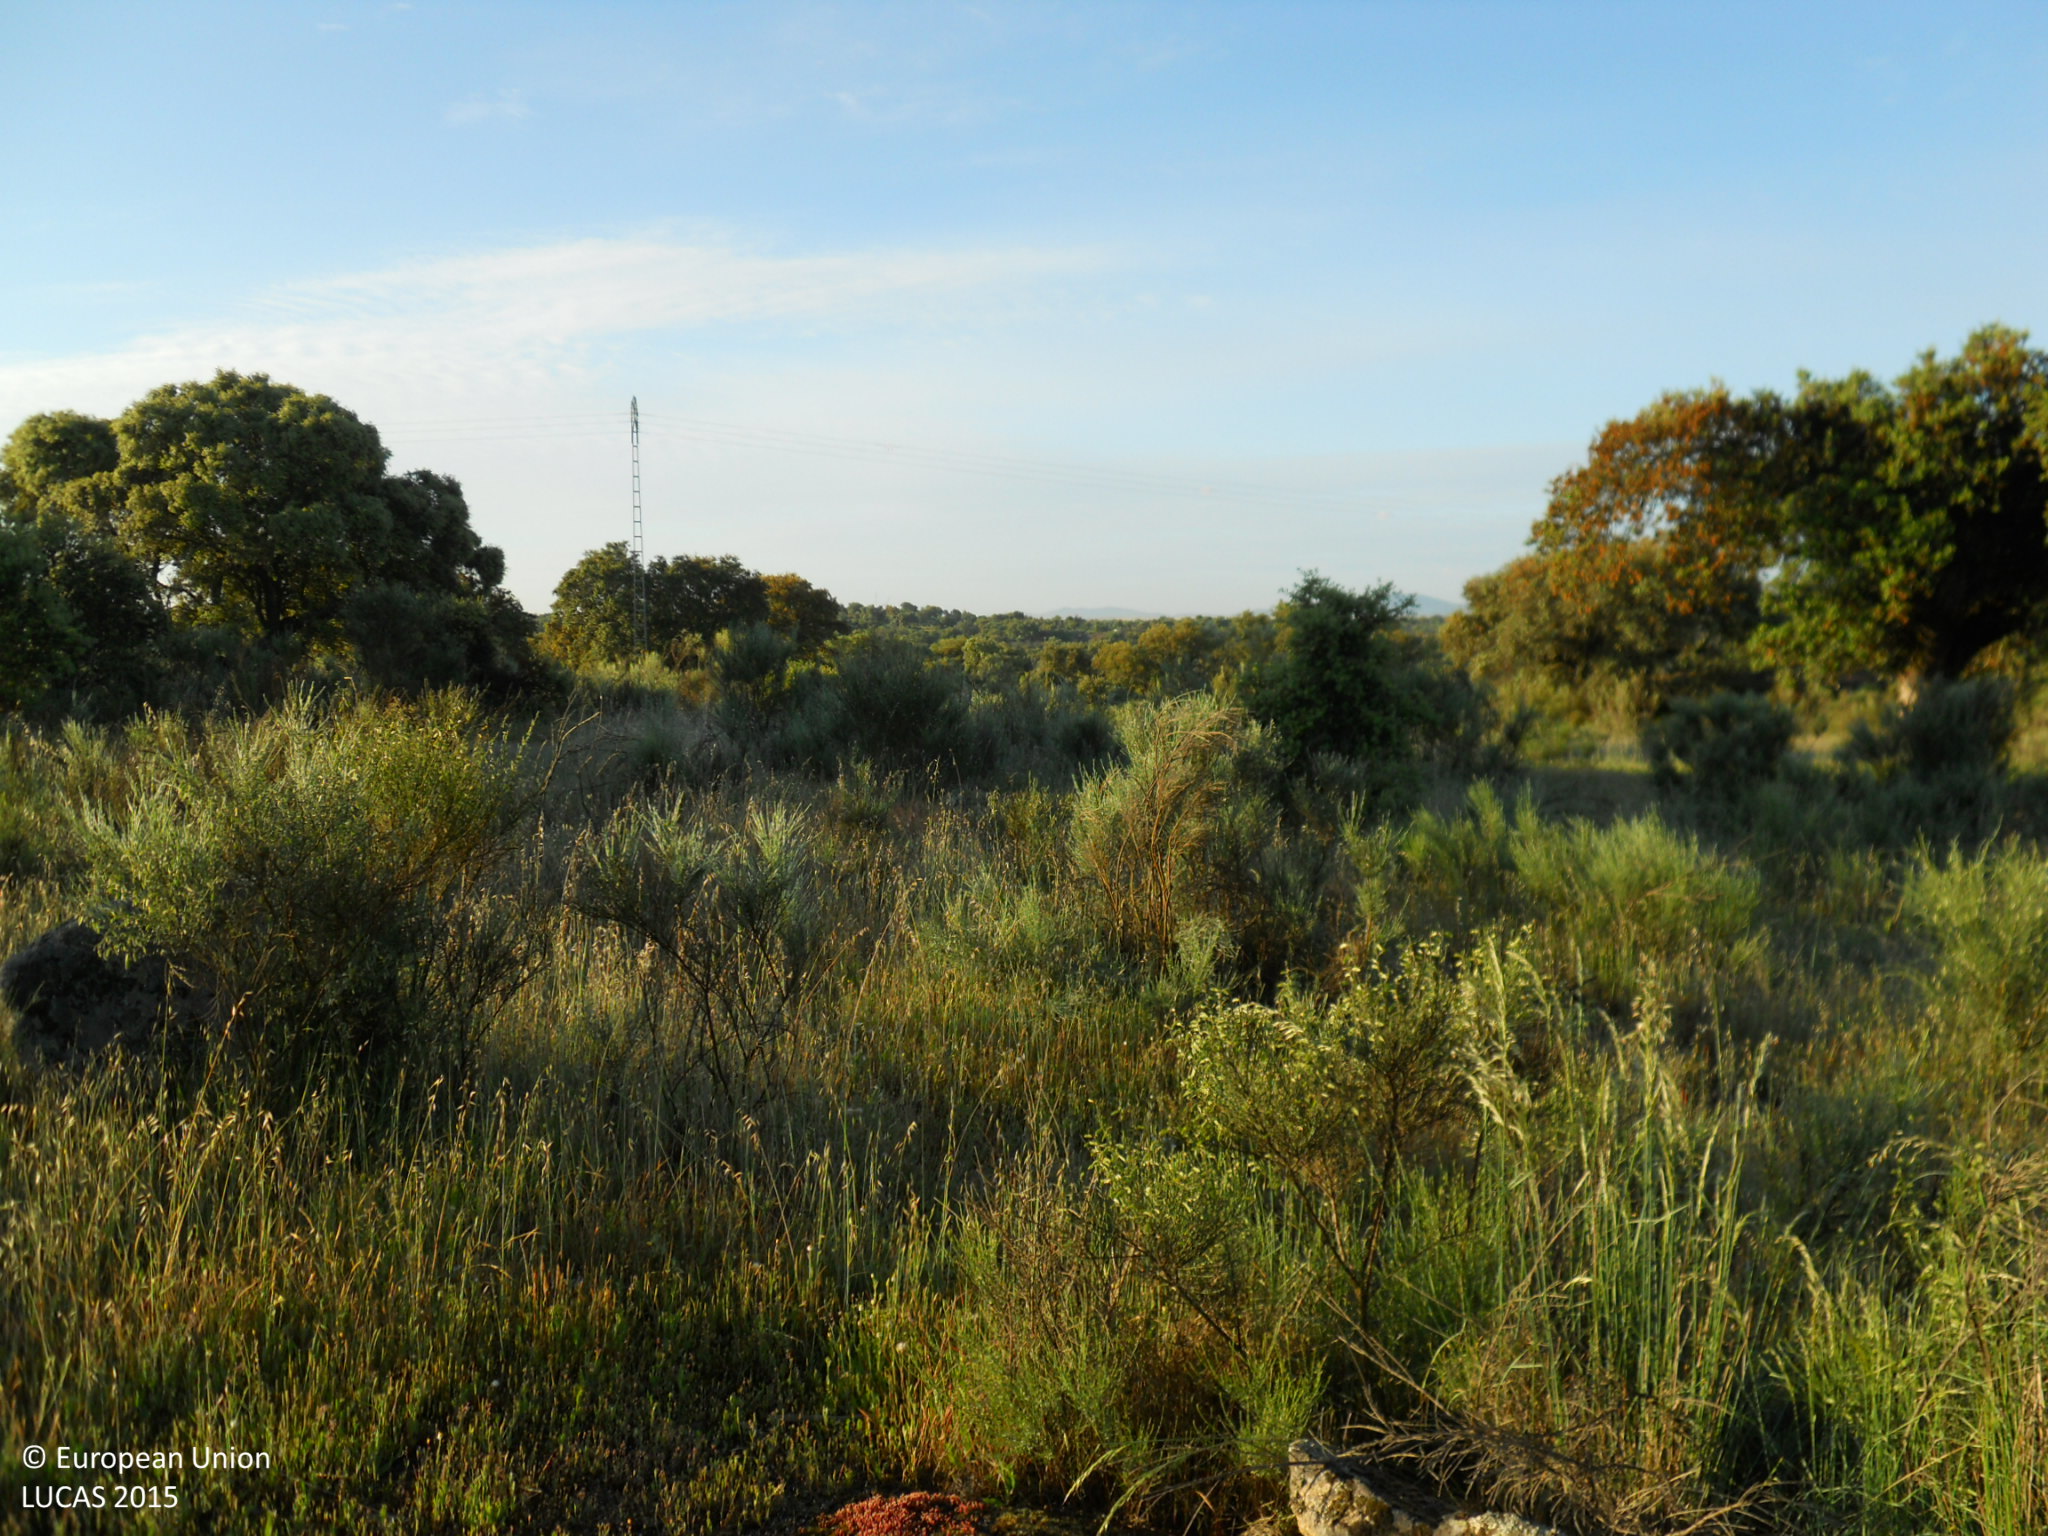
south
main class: Shrubland
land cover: Shrubland with sparse tree cover
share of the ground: > 75 %
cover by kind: shrubs 90 %, broadleaved forest trees 5 %, herbaceous plants 5 %
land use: Agriculture (excluding fallow land and kitchen gardens)
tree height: > 5 m
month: April
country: ES
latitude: 39.4055
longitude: -6.4310
